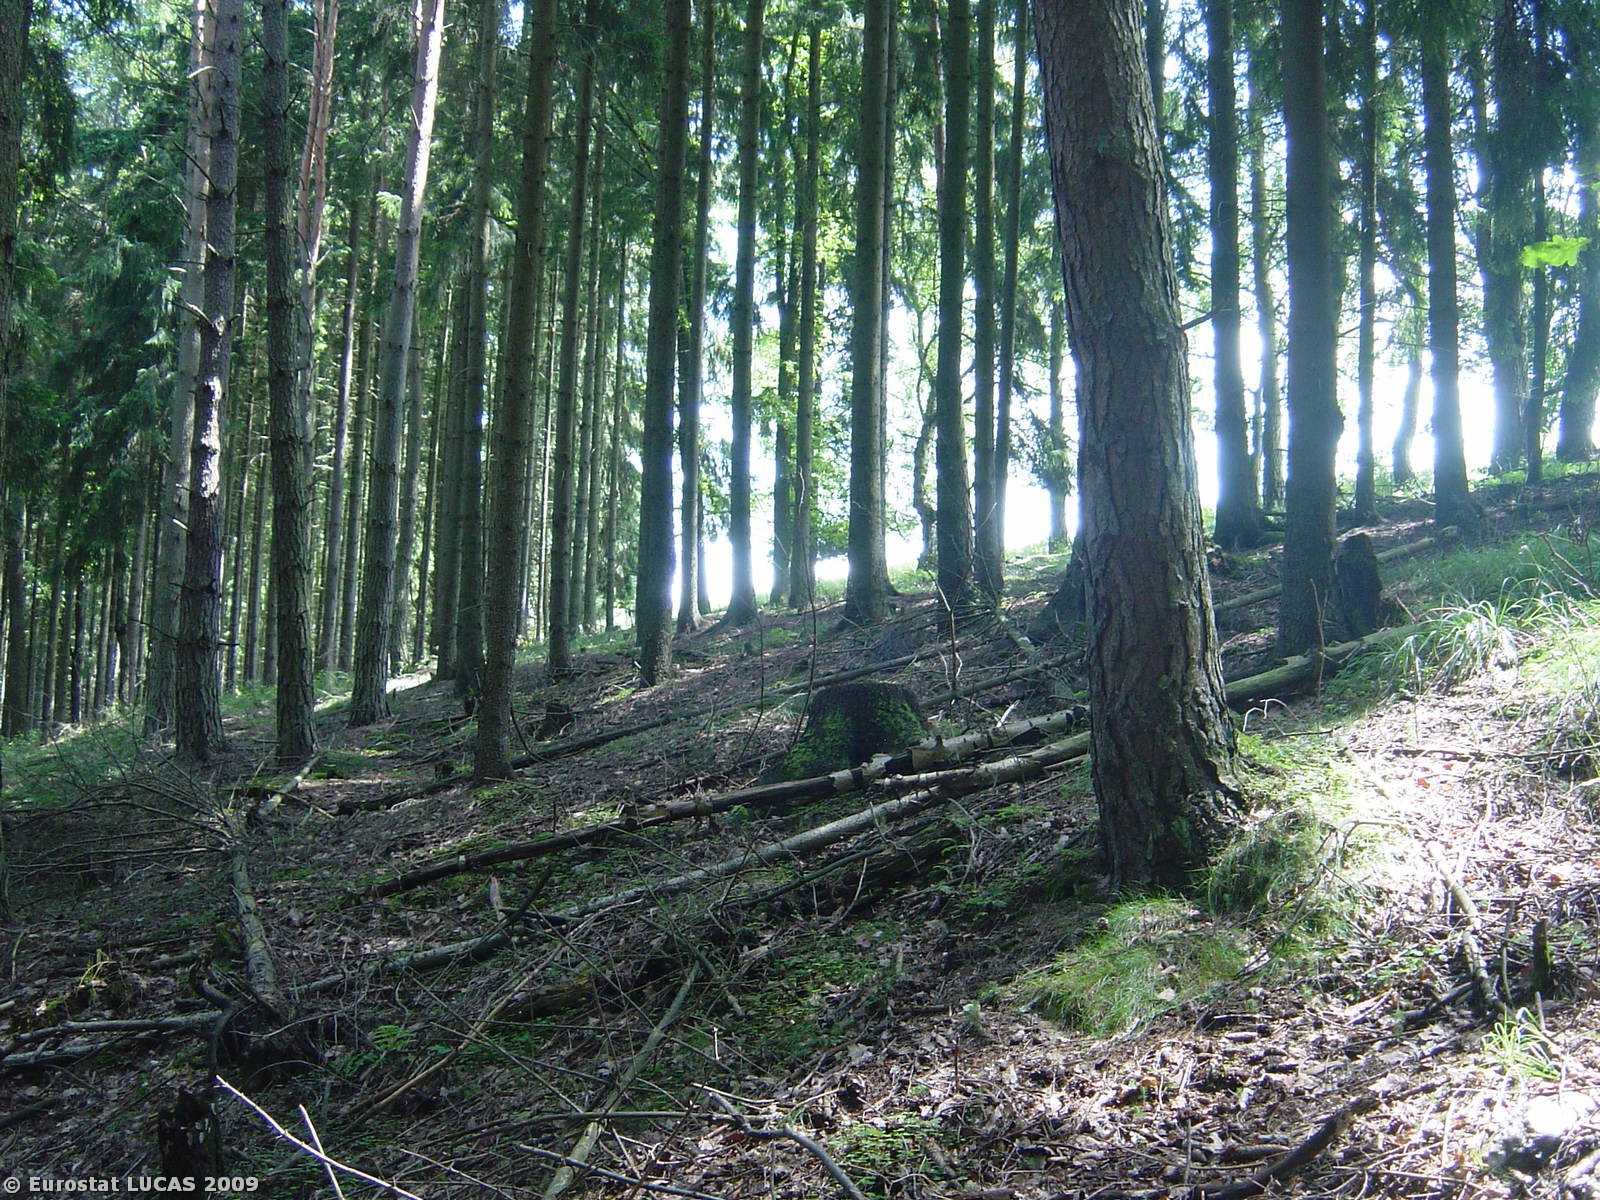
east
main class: Woodland
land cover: Coniferous woodland
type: hemiboreal forest and nemoral coniferous forest and mixed broadleaved-coniferous forest
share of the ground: > 75 %
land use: Forestry
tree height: > 5 m
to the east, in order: Coniferous woodland; Mixed woodland; Grassland without tree/shrub cover
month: July
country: CZ
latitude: 49.8952
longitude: 12.9093
